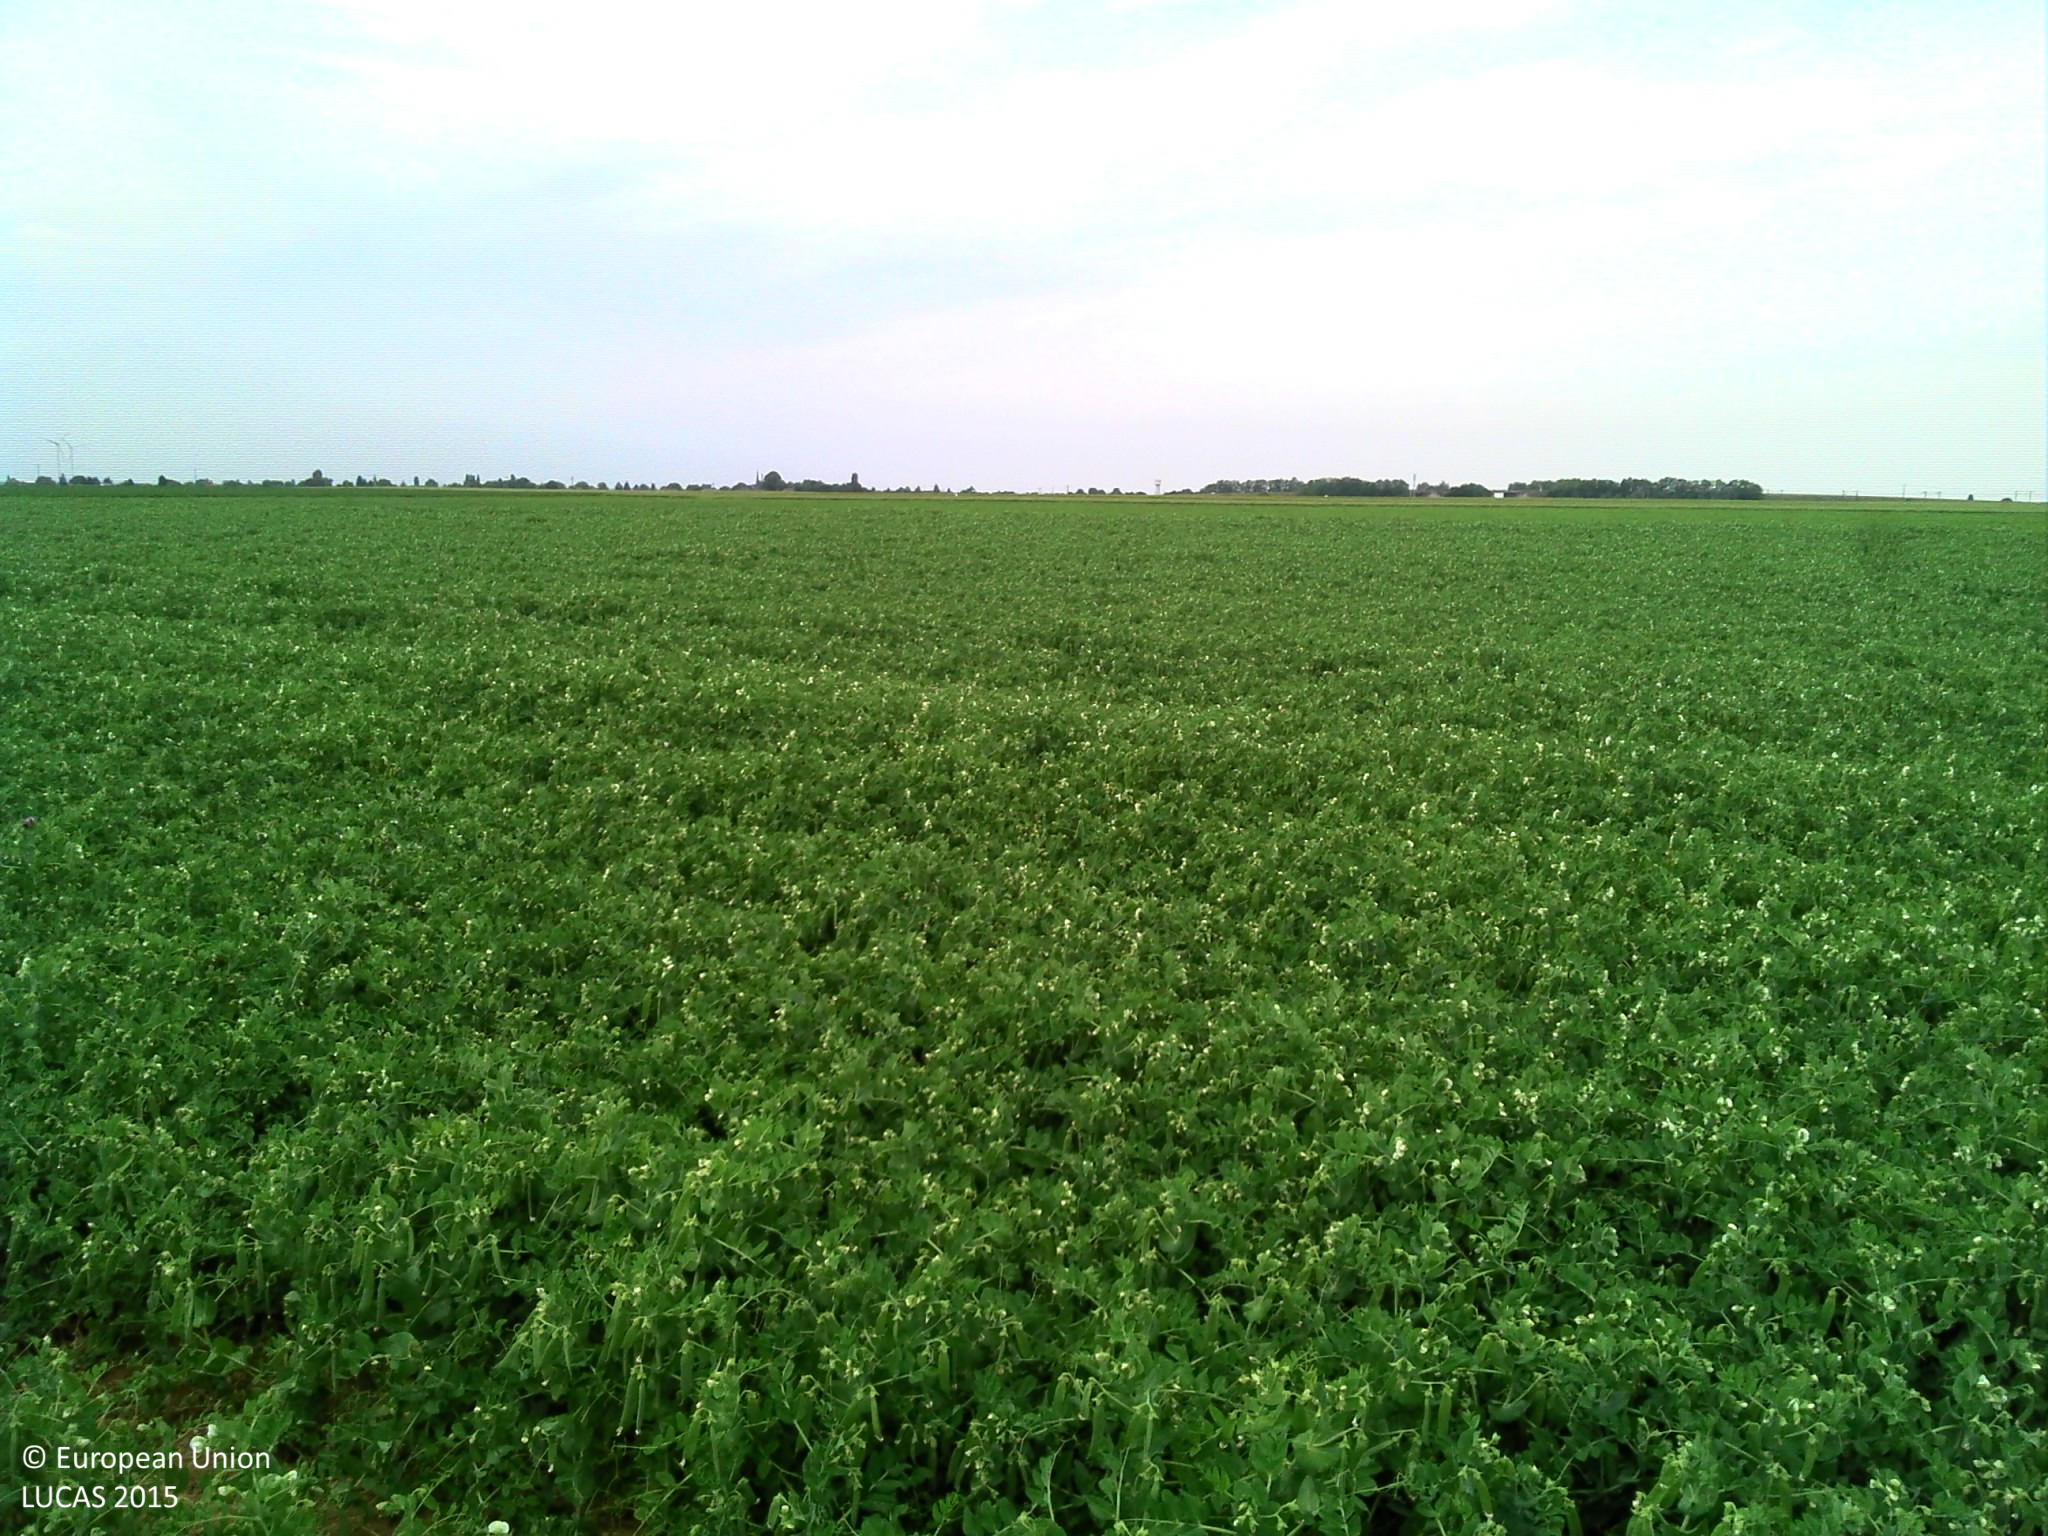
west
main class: Cropland
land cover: Dry pulses
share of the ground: > 75 %
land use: Agriculture (excluding fallow land and kitchen gardens)
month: June
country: FR
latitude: 48.2177
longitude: 1.4640
